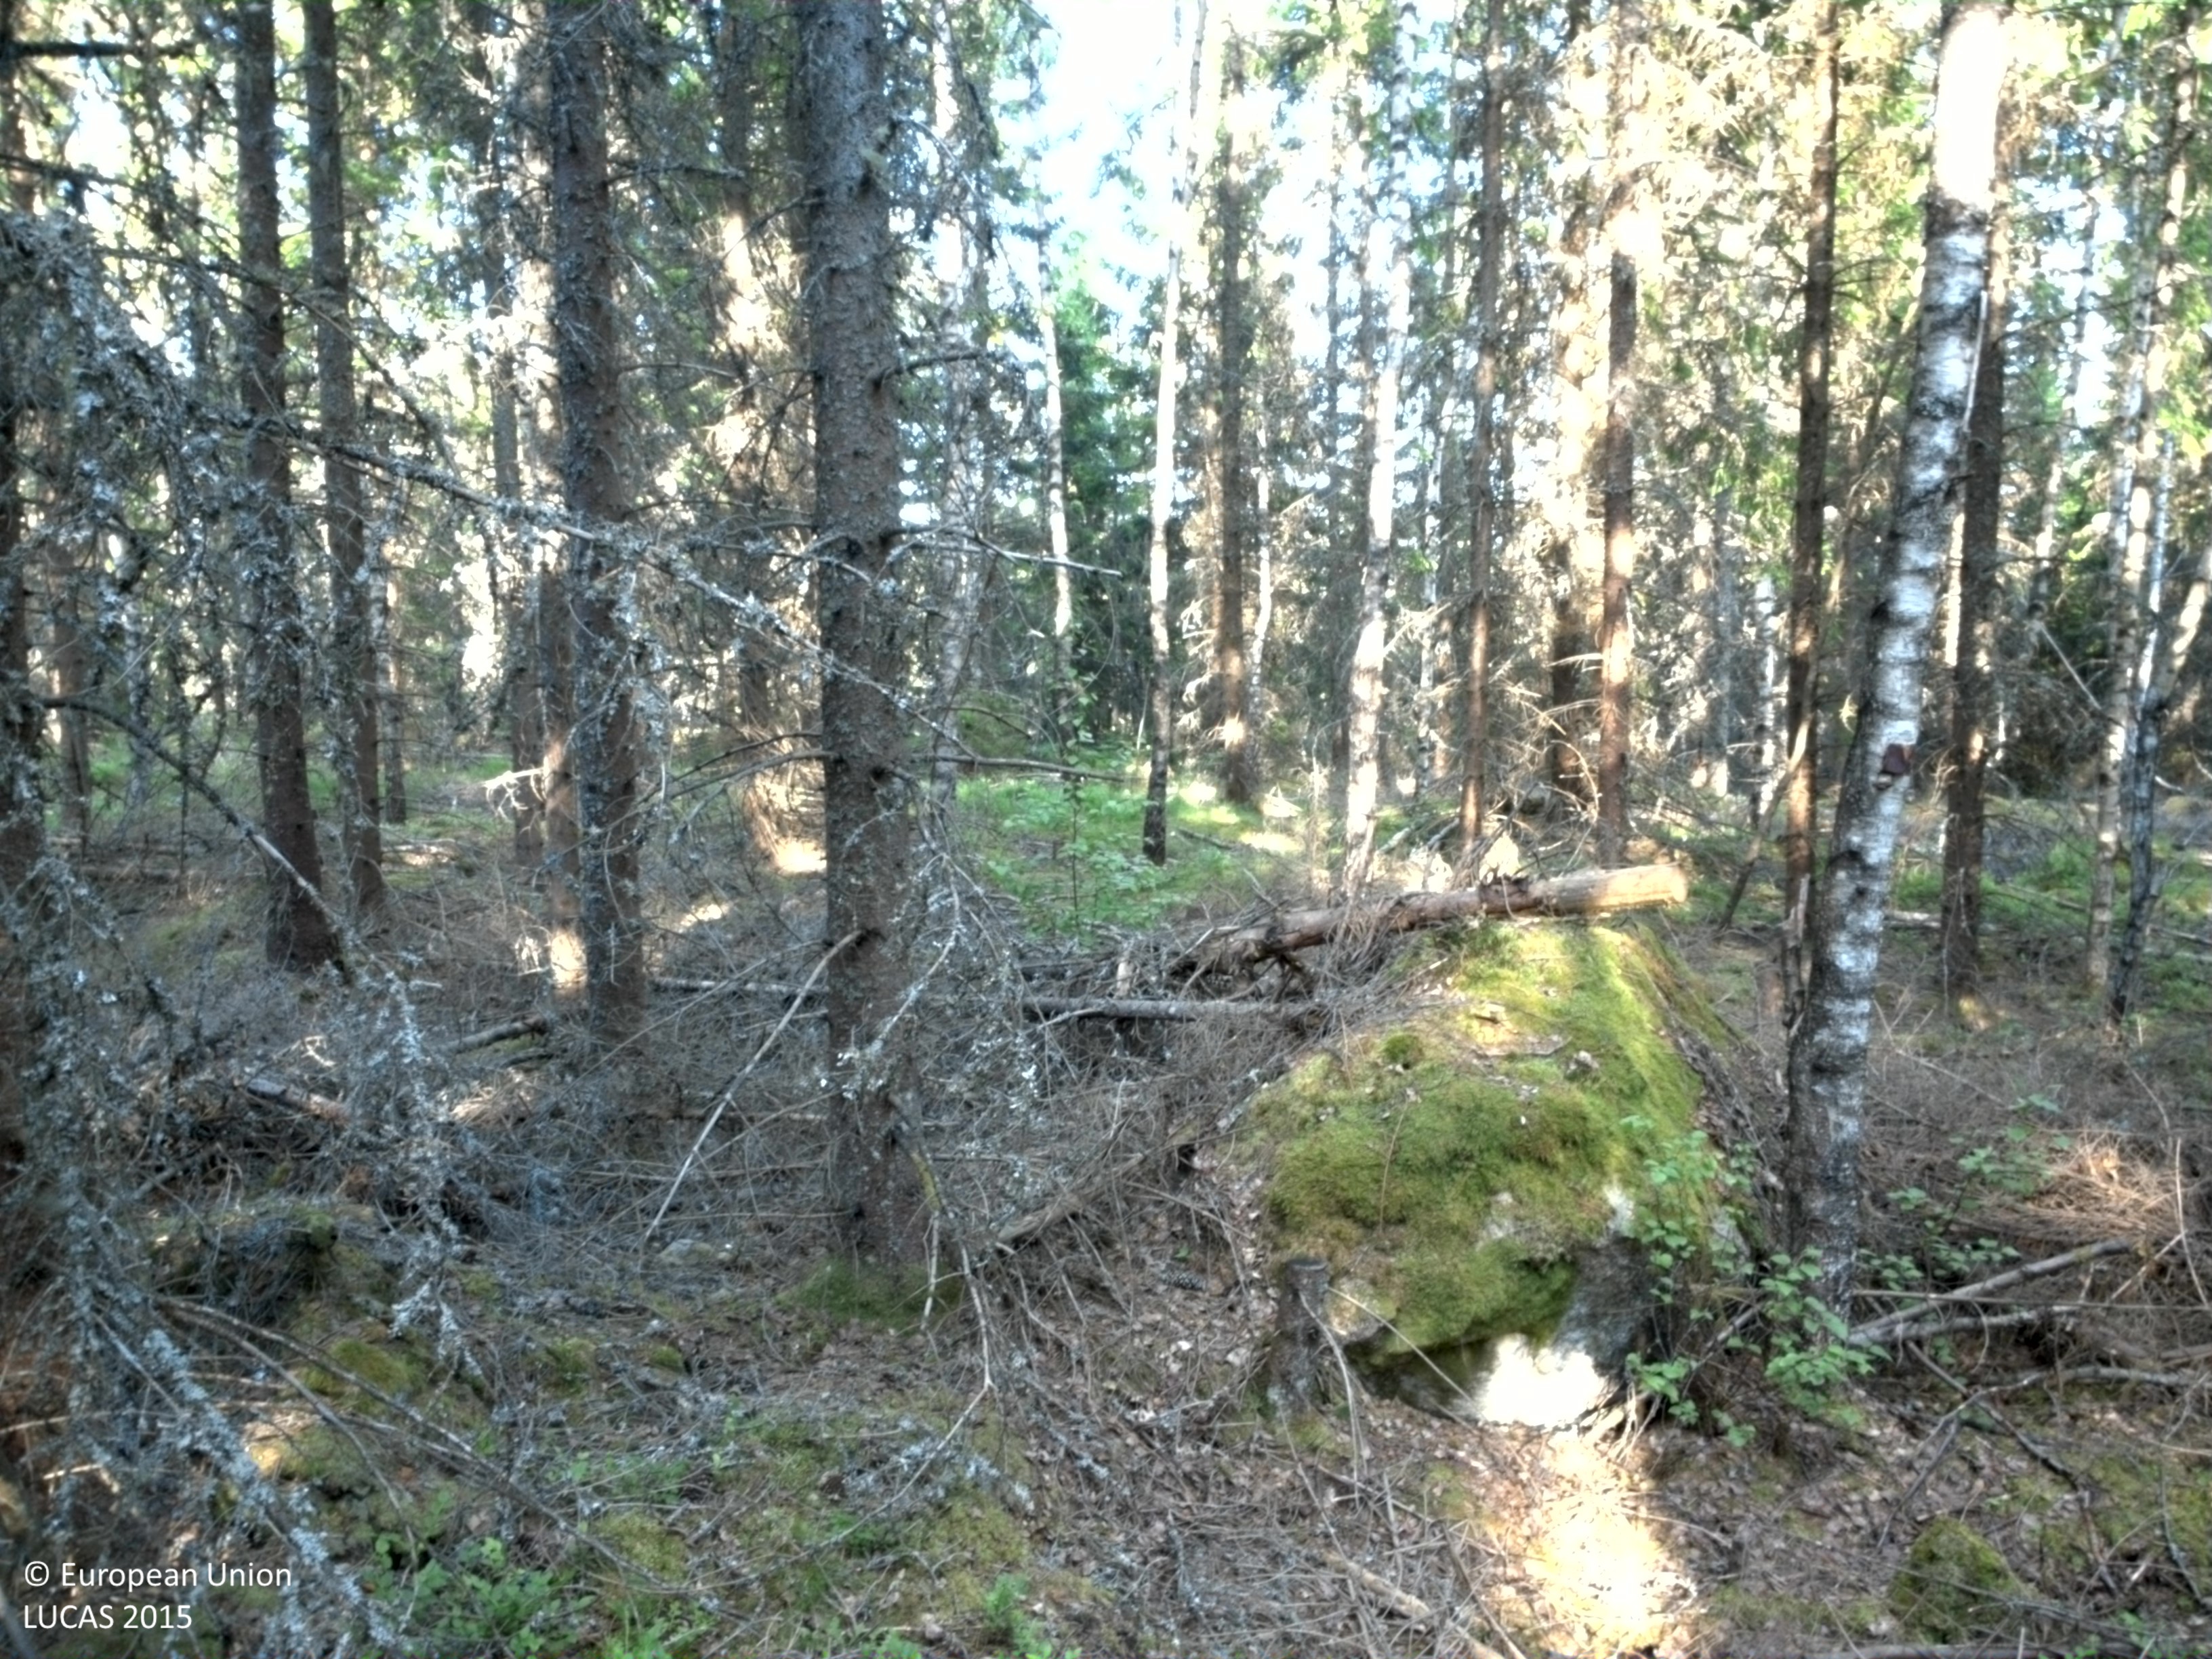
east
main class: Woodland
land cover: Spruce dominated coniferous woodland
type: boreal forest
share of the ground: 50 - 75 %
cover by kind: coniferous forest trees 65 %, lichens and mosses 20 %, broadleaved forest trees 10 %, shrubs 5 %
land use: Forestry
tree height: > 5 m
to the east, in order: Spruce dominated coniferous woodland; Pine dominated mixed woodland; Spontaneously vegetated surfaces; Lichens and moss; Shrubland with sparse tree cover; Spontaneously vegetated surfaces; Ditches and canals; Grass margins; Paved roads, cycling and walking lanes; Grass margins; Ditches and canals; Spruce dominated mixed woodland
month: June
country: SE
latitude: 58.6154
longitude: 14.4177
